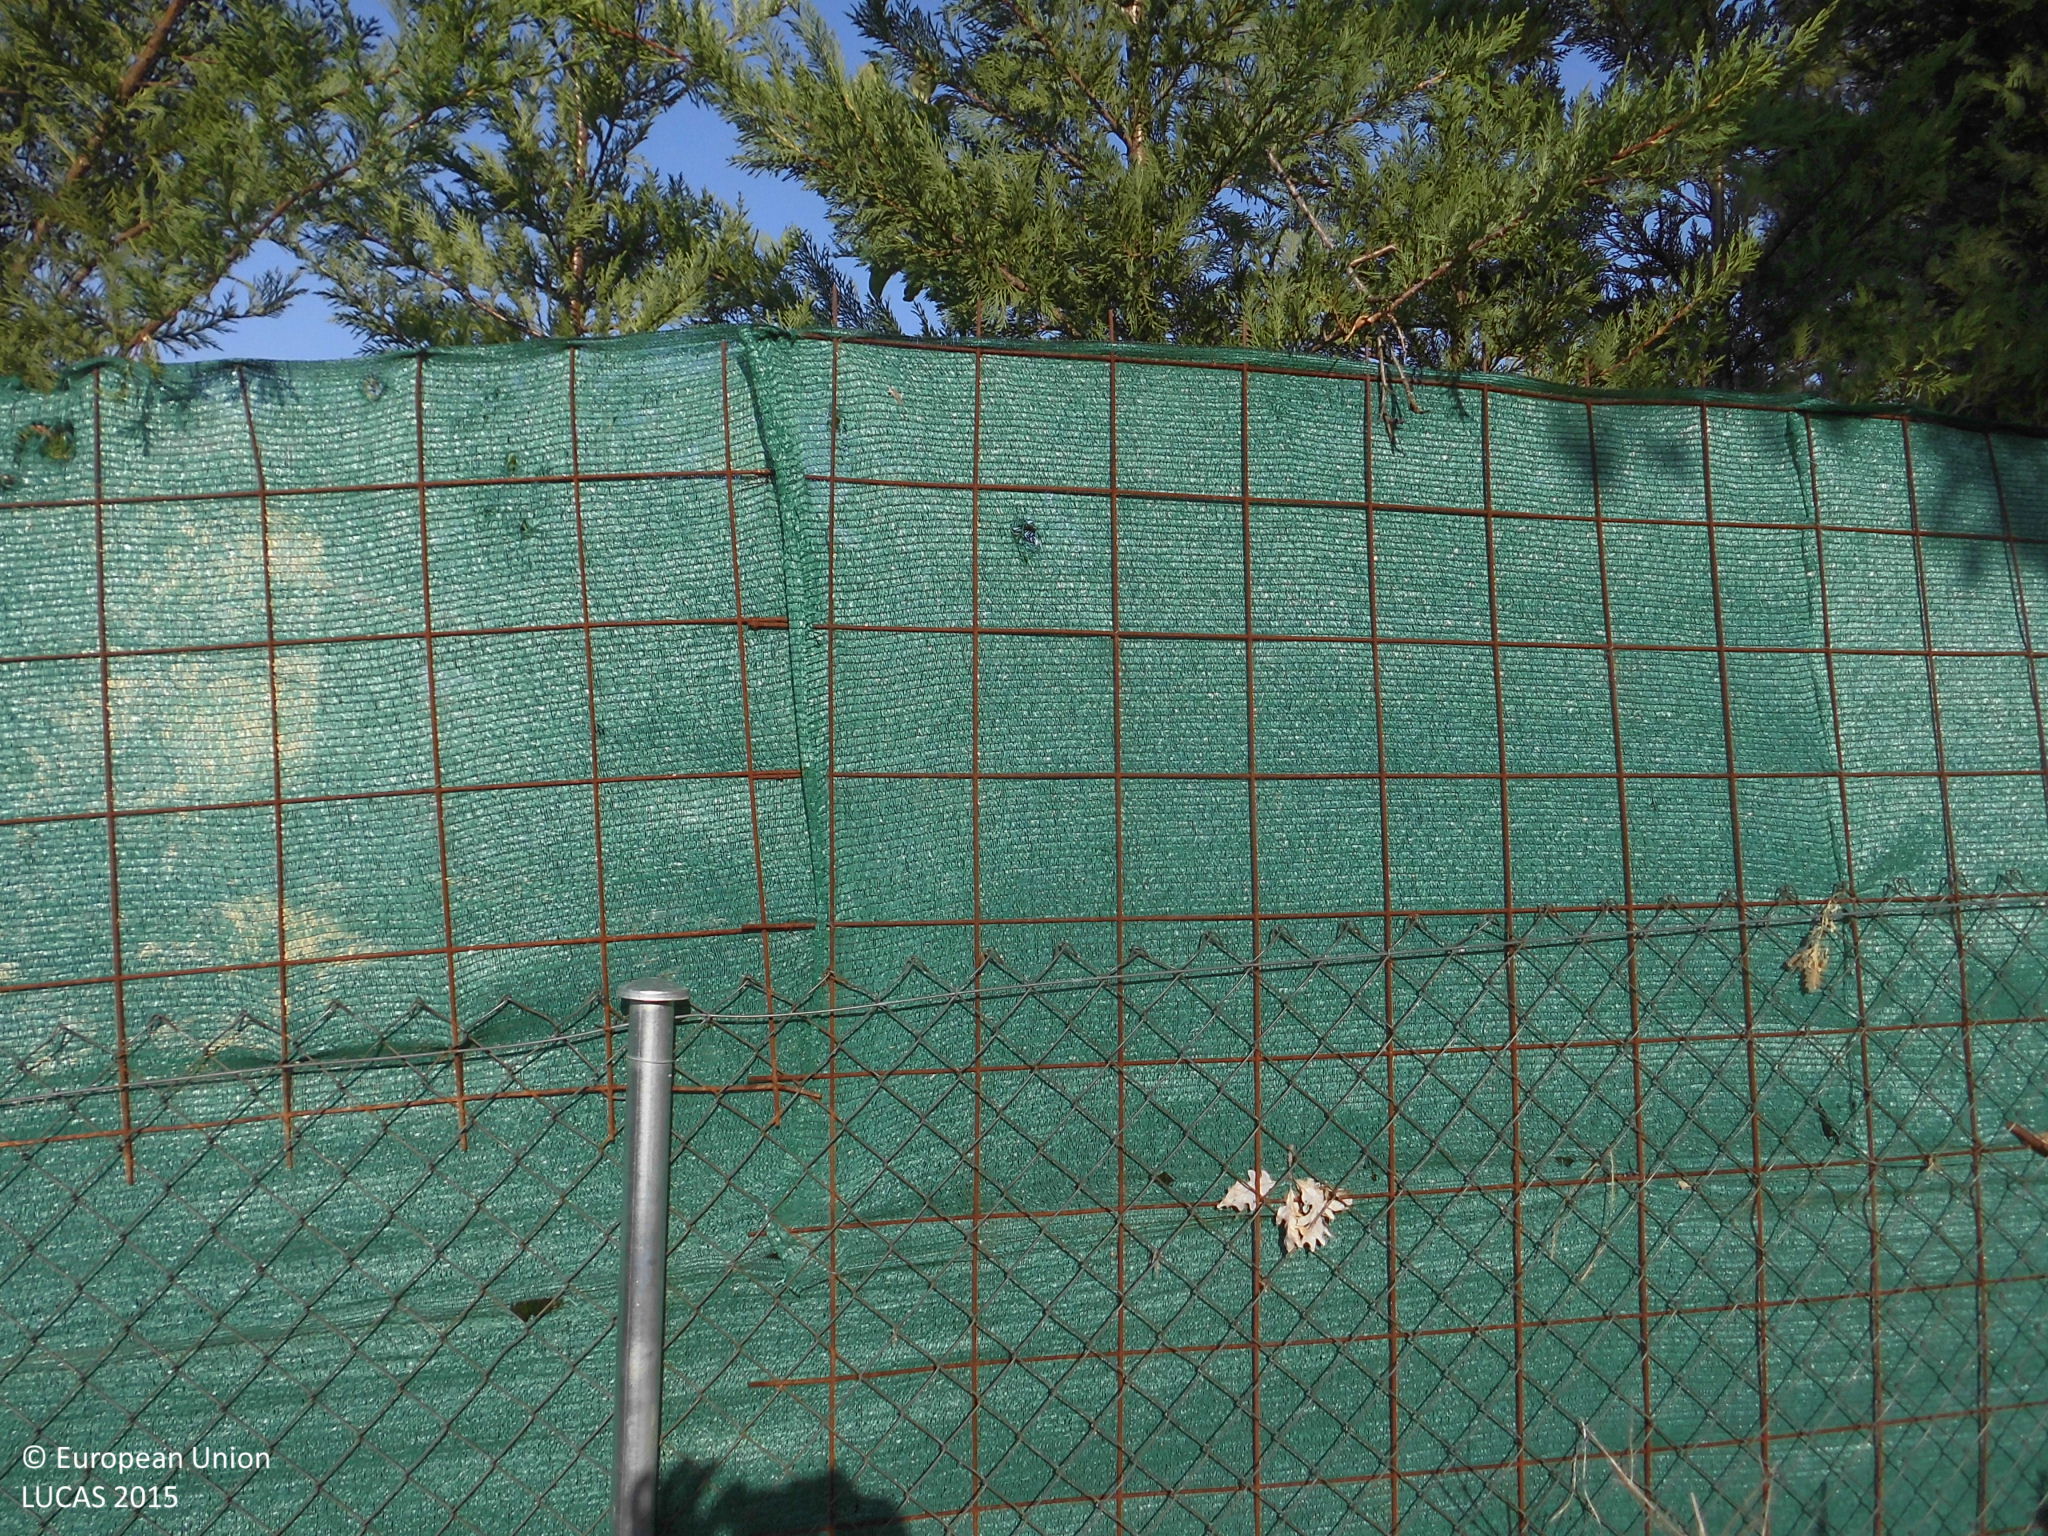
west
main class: Shrubland
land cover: Shrubland with sparse tree cover
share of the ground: > 75 %
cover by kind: shrubs 75 %, herbaceous plants 20 %, broadleaved forest trees 5 %
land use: Residential
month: June
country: ES
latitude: 40.1383
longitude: -5.4481
